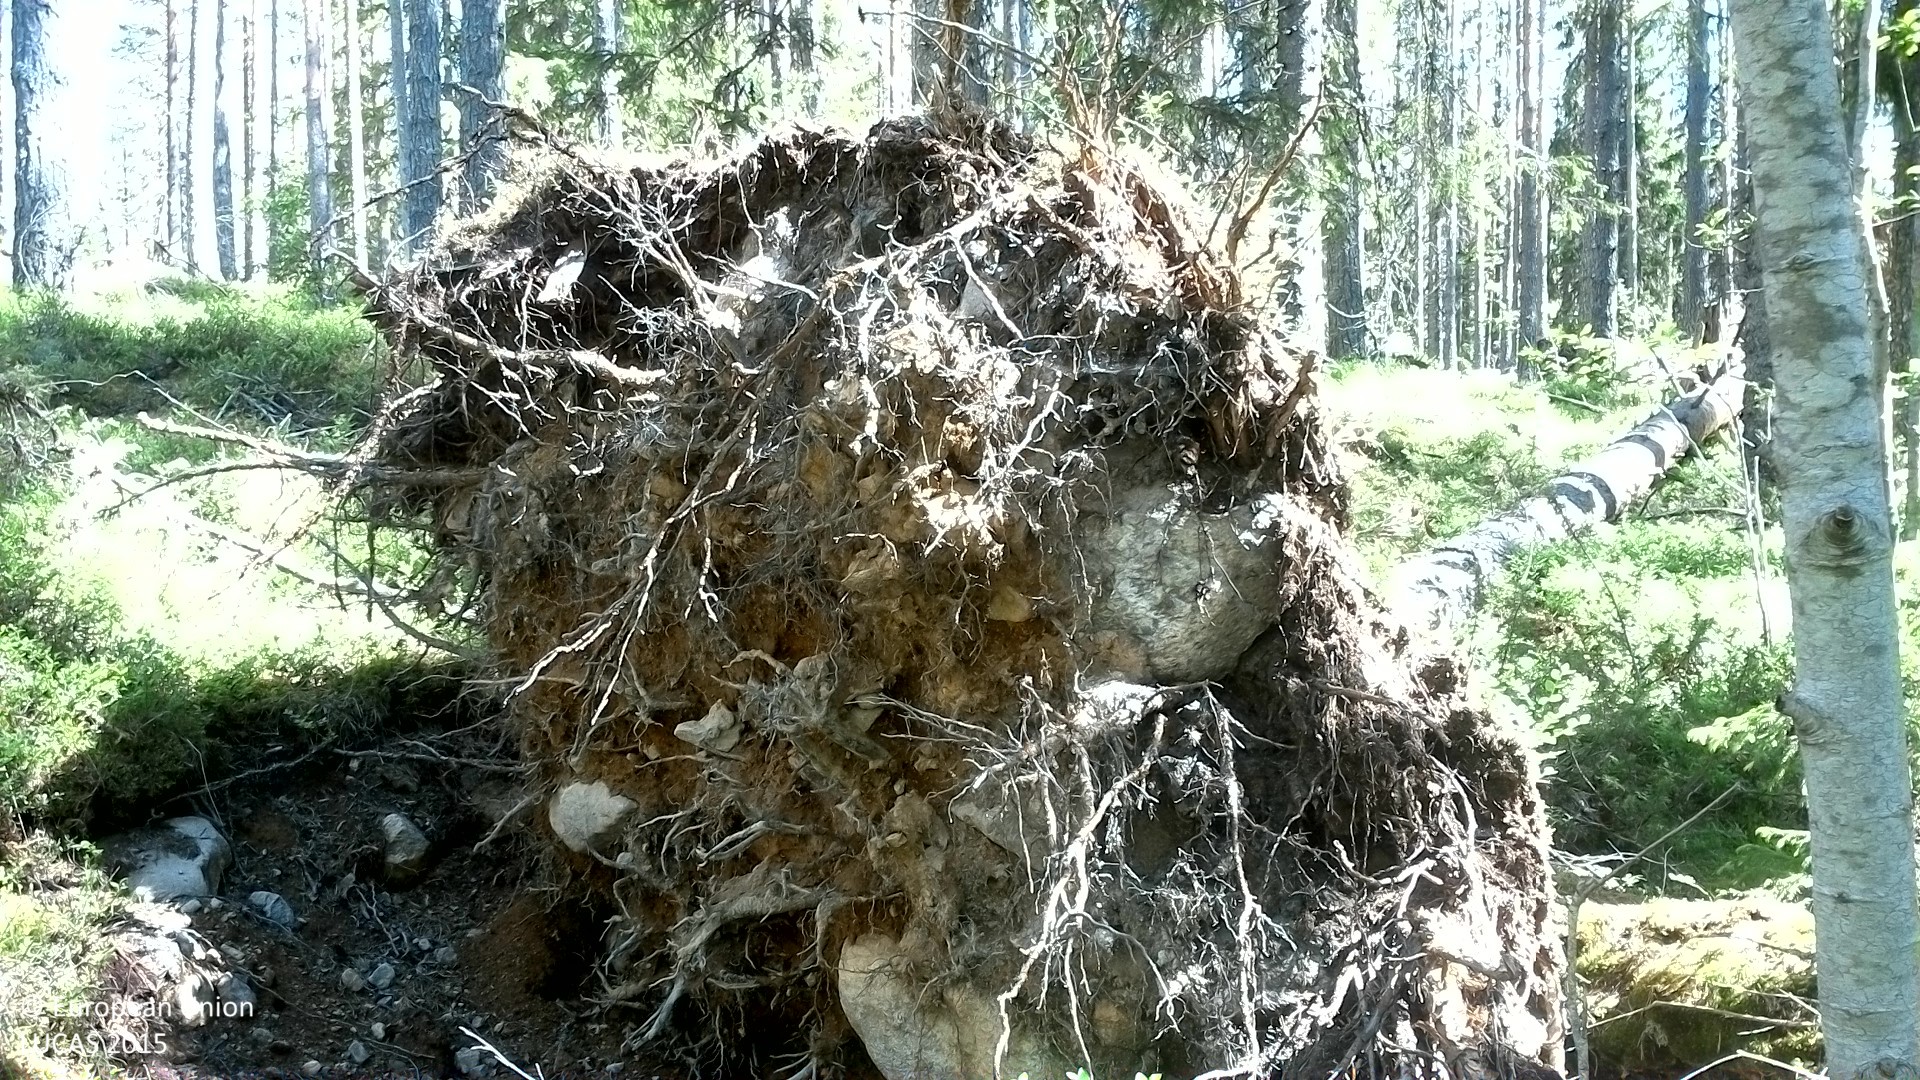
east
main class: Woodland
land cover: Pine dominated coniferous woodland
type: boreal forest
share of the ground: 25 - 50 %
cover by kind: coniferous forest trees 45 %, shrubs 40 %, lichens and mosses 10 %, broadleaved forest trees 5 %
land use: Forestry
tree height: > 5 m
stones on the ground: 10 - 25 %
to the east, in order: Pine dominated coniferous woodland; Spruce dominated coniferous woodland; Pine dominated coniferous woodland; Ditches and canals; Paved roads, cycling and walking lanes; Ditches and canals; Pine dominated coniferous woodland; Tracks; Spruce dominated coniferous woodland
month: June
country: SE
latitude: 62.0523
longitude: 16.1592
